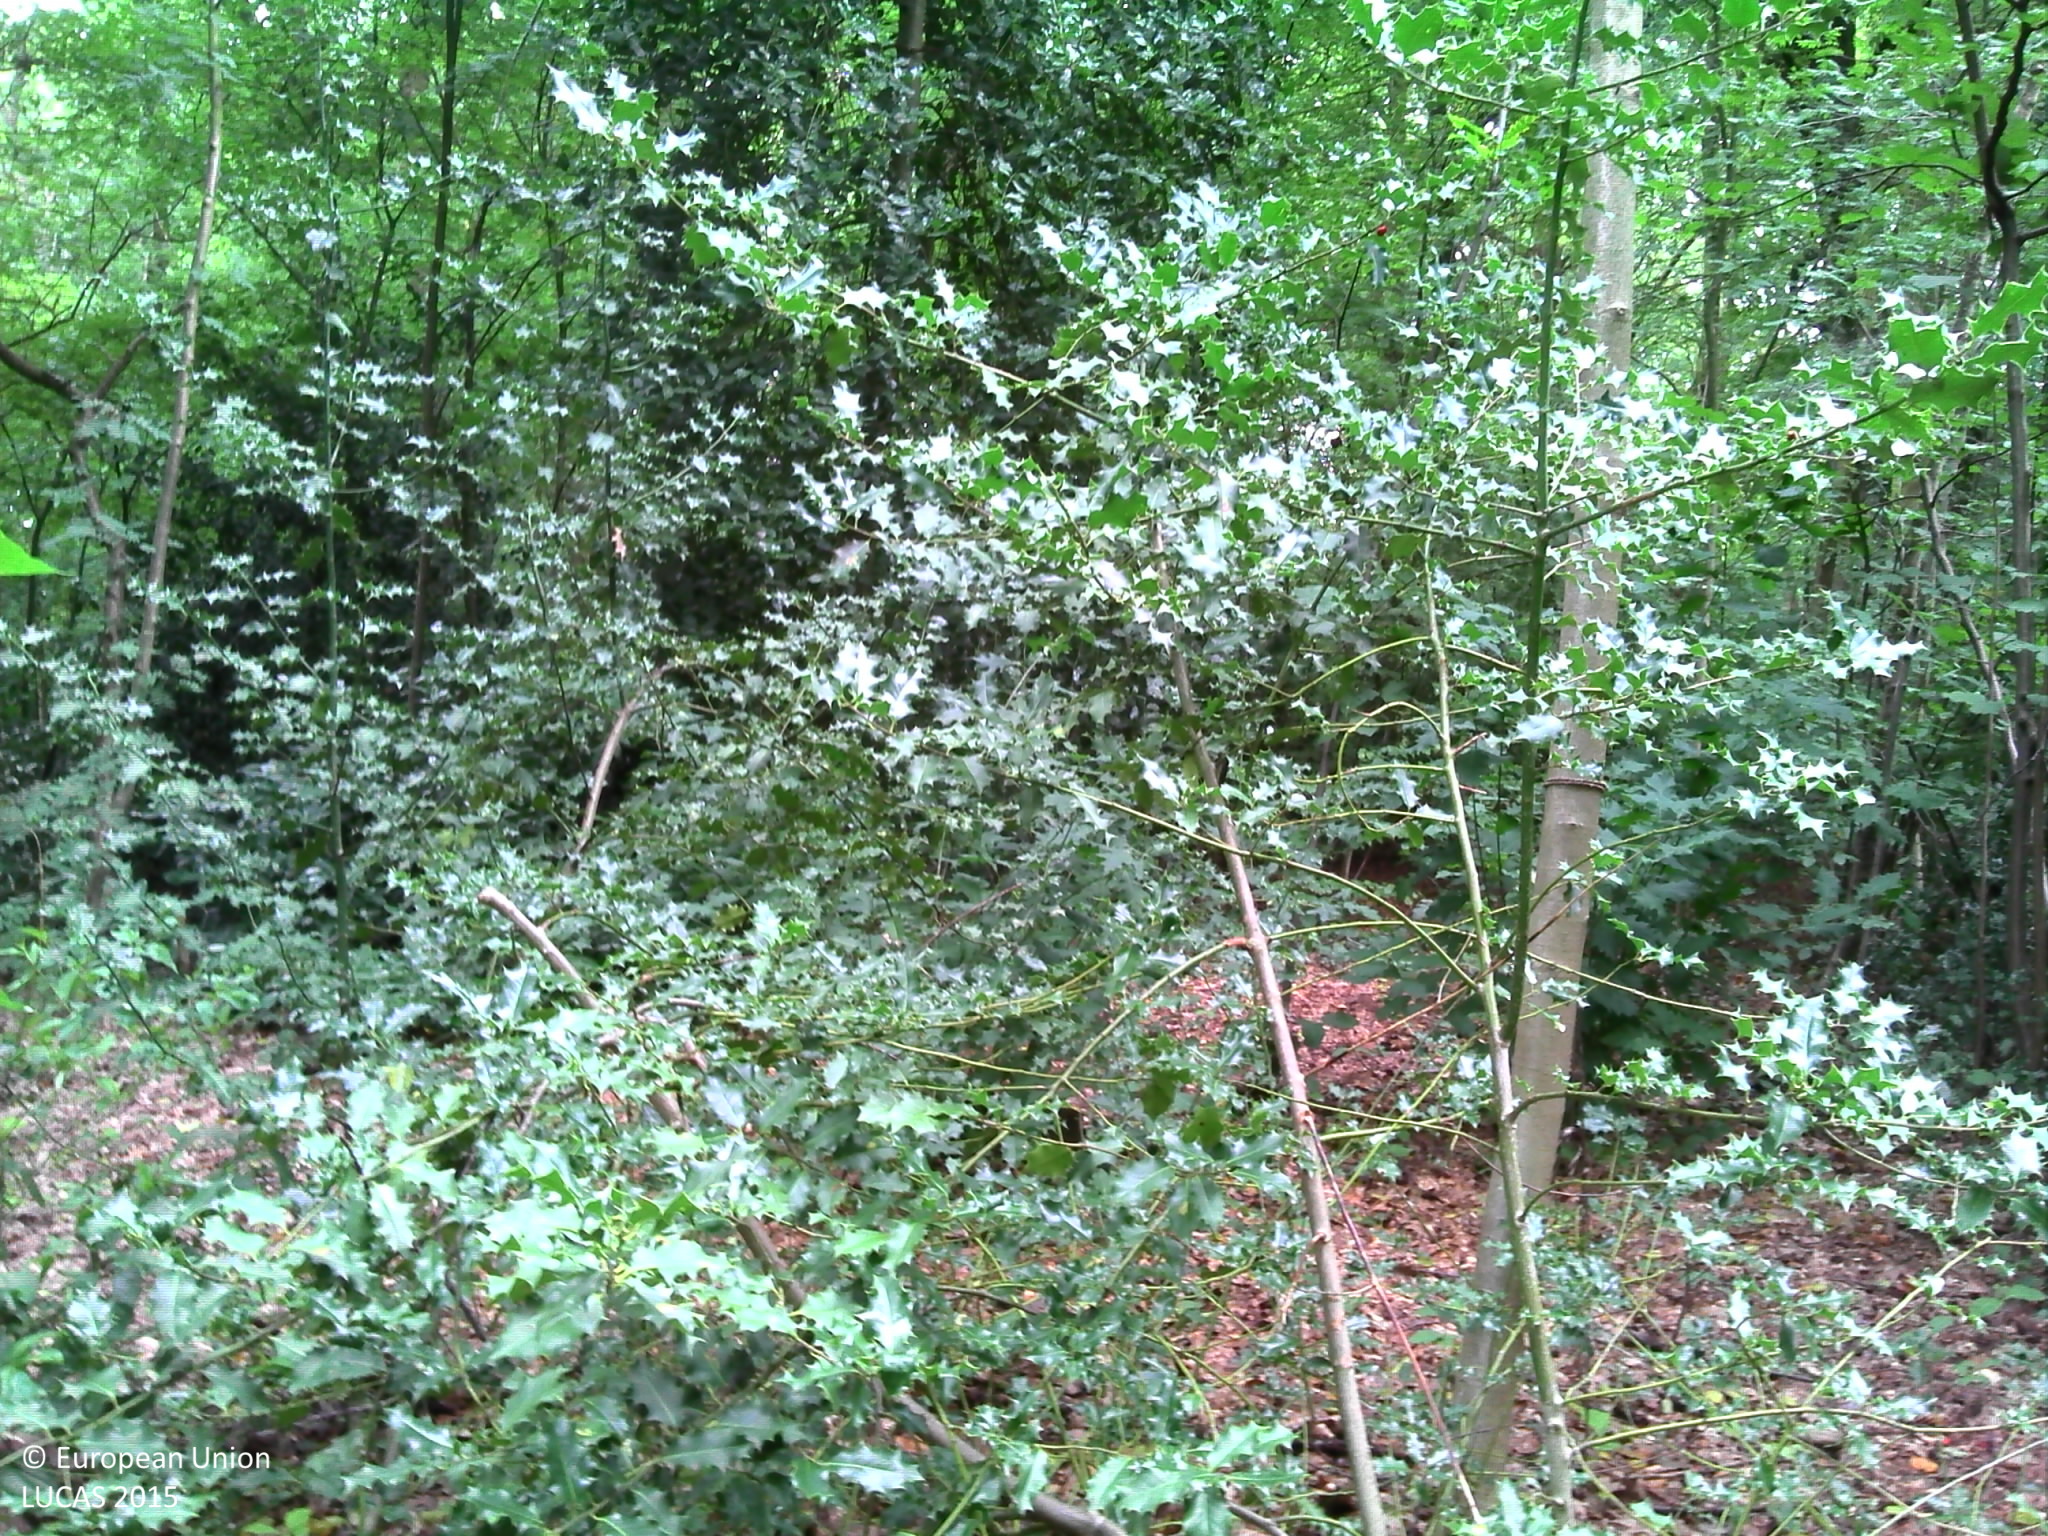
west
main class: Woodland
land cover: Broadleaved woodland
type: beech forest
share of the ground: 50 - 75 %
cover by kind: broadleaved forest trees 60 %, shrubs 20 %, unconsolidated bare surface 20 %
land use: Amenities, museums, leisure
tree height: > 5 m
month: September
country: BE
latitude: 51.1822
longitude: 4.4018
